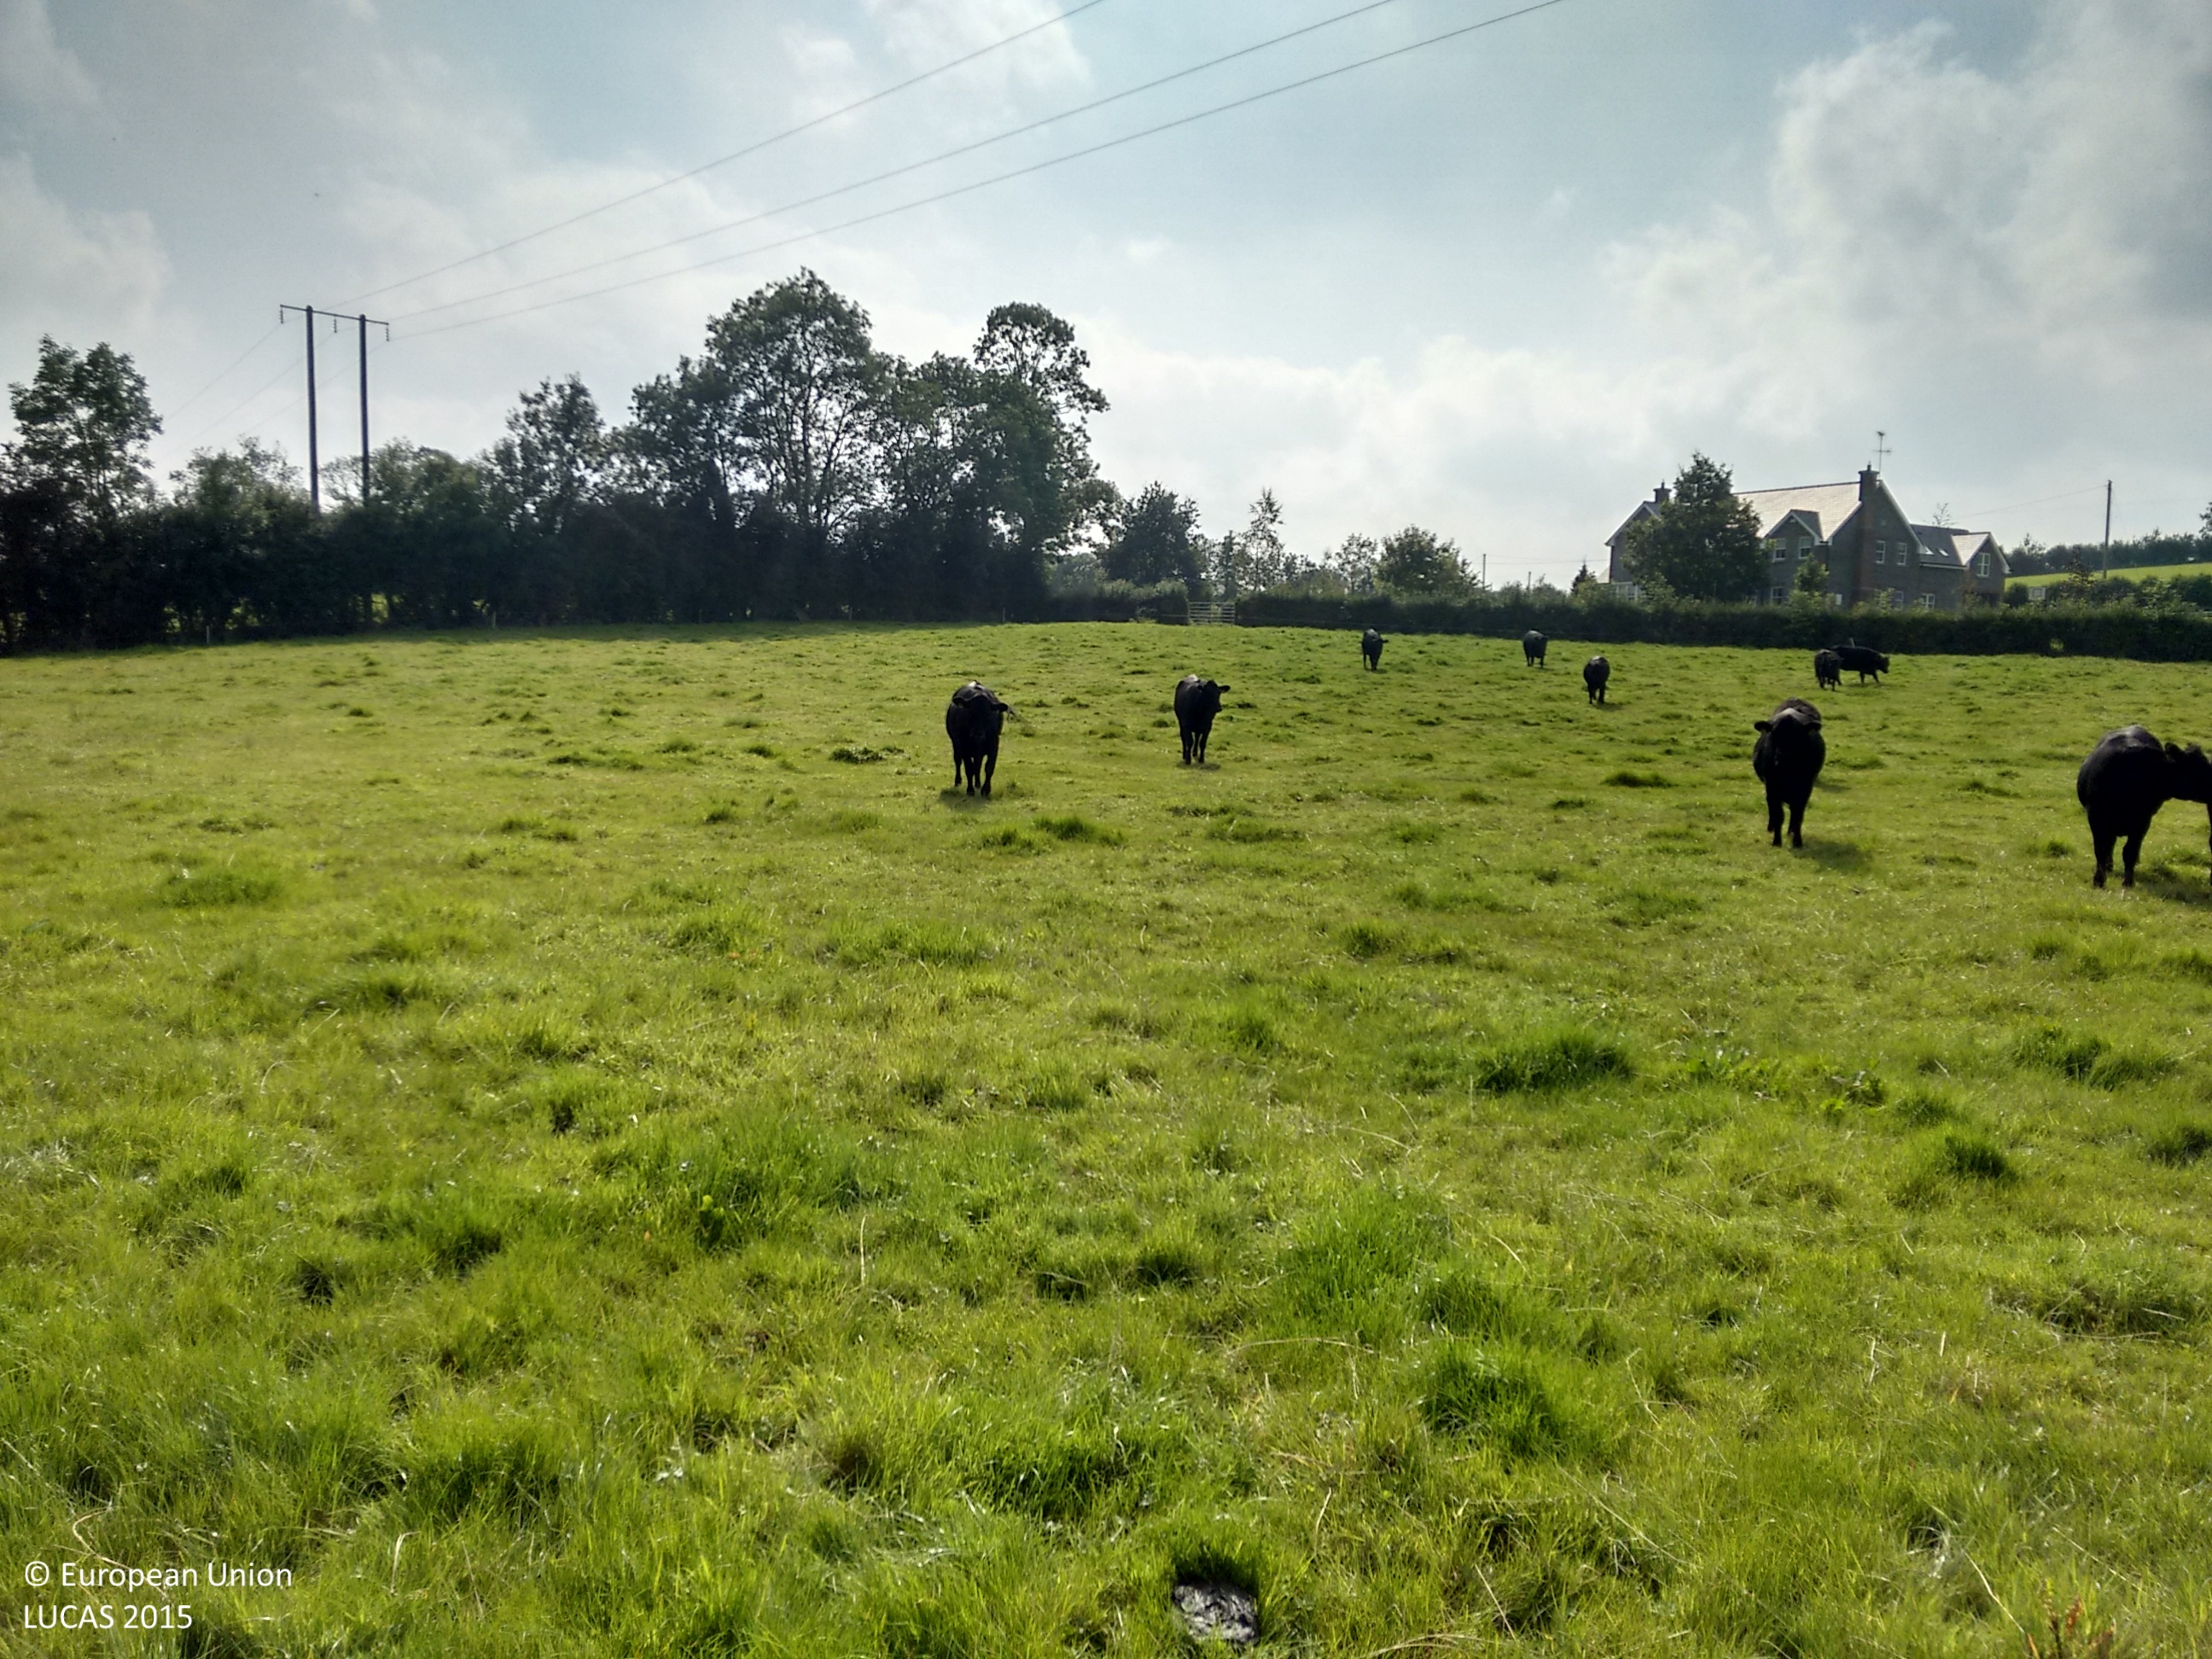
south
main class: Grassland
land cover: Grassland without tree/shrub cover
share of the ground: > 75 %
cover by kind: herbaceous plants 100 %
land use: Agriculture (excluding fallow land and kitchen gardens)
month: September
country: IE
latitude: 54.2690
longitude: -6.9840
